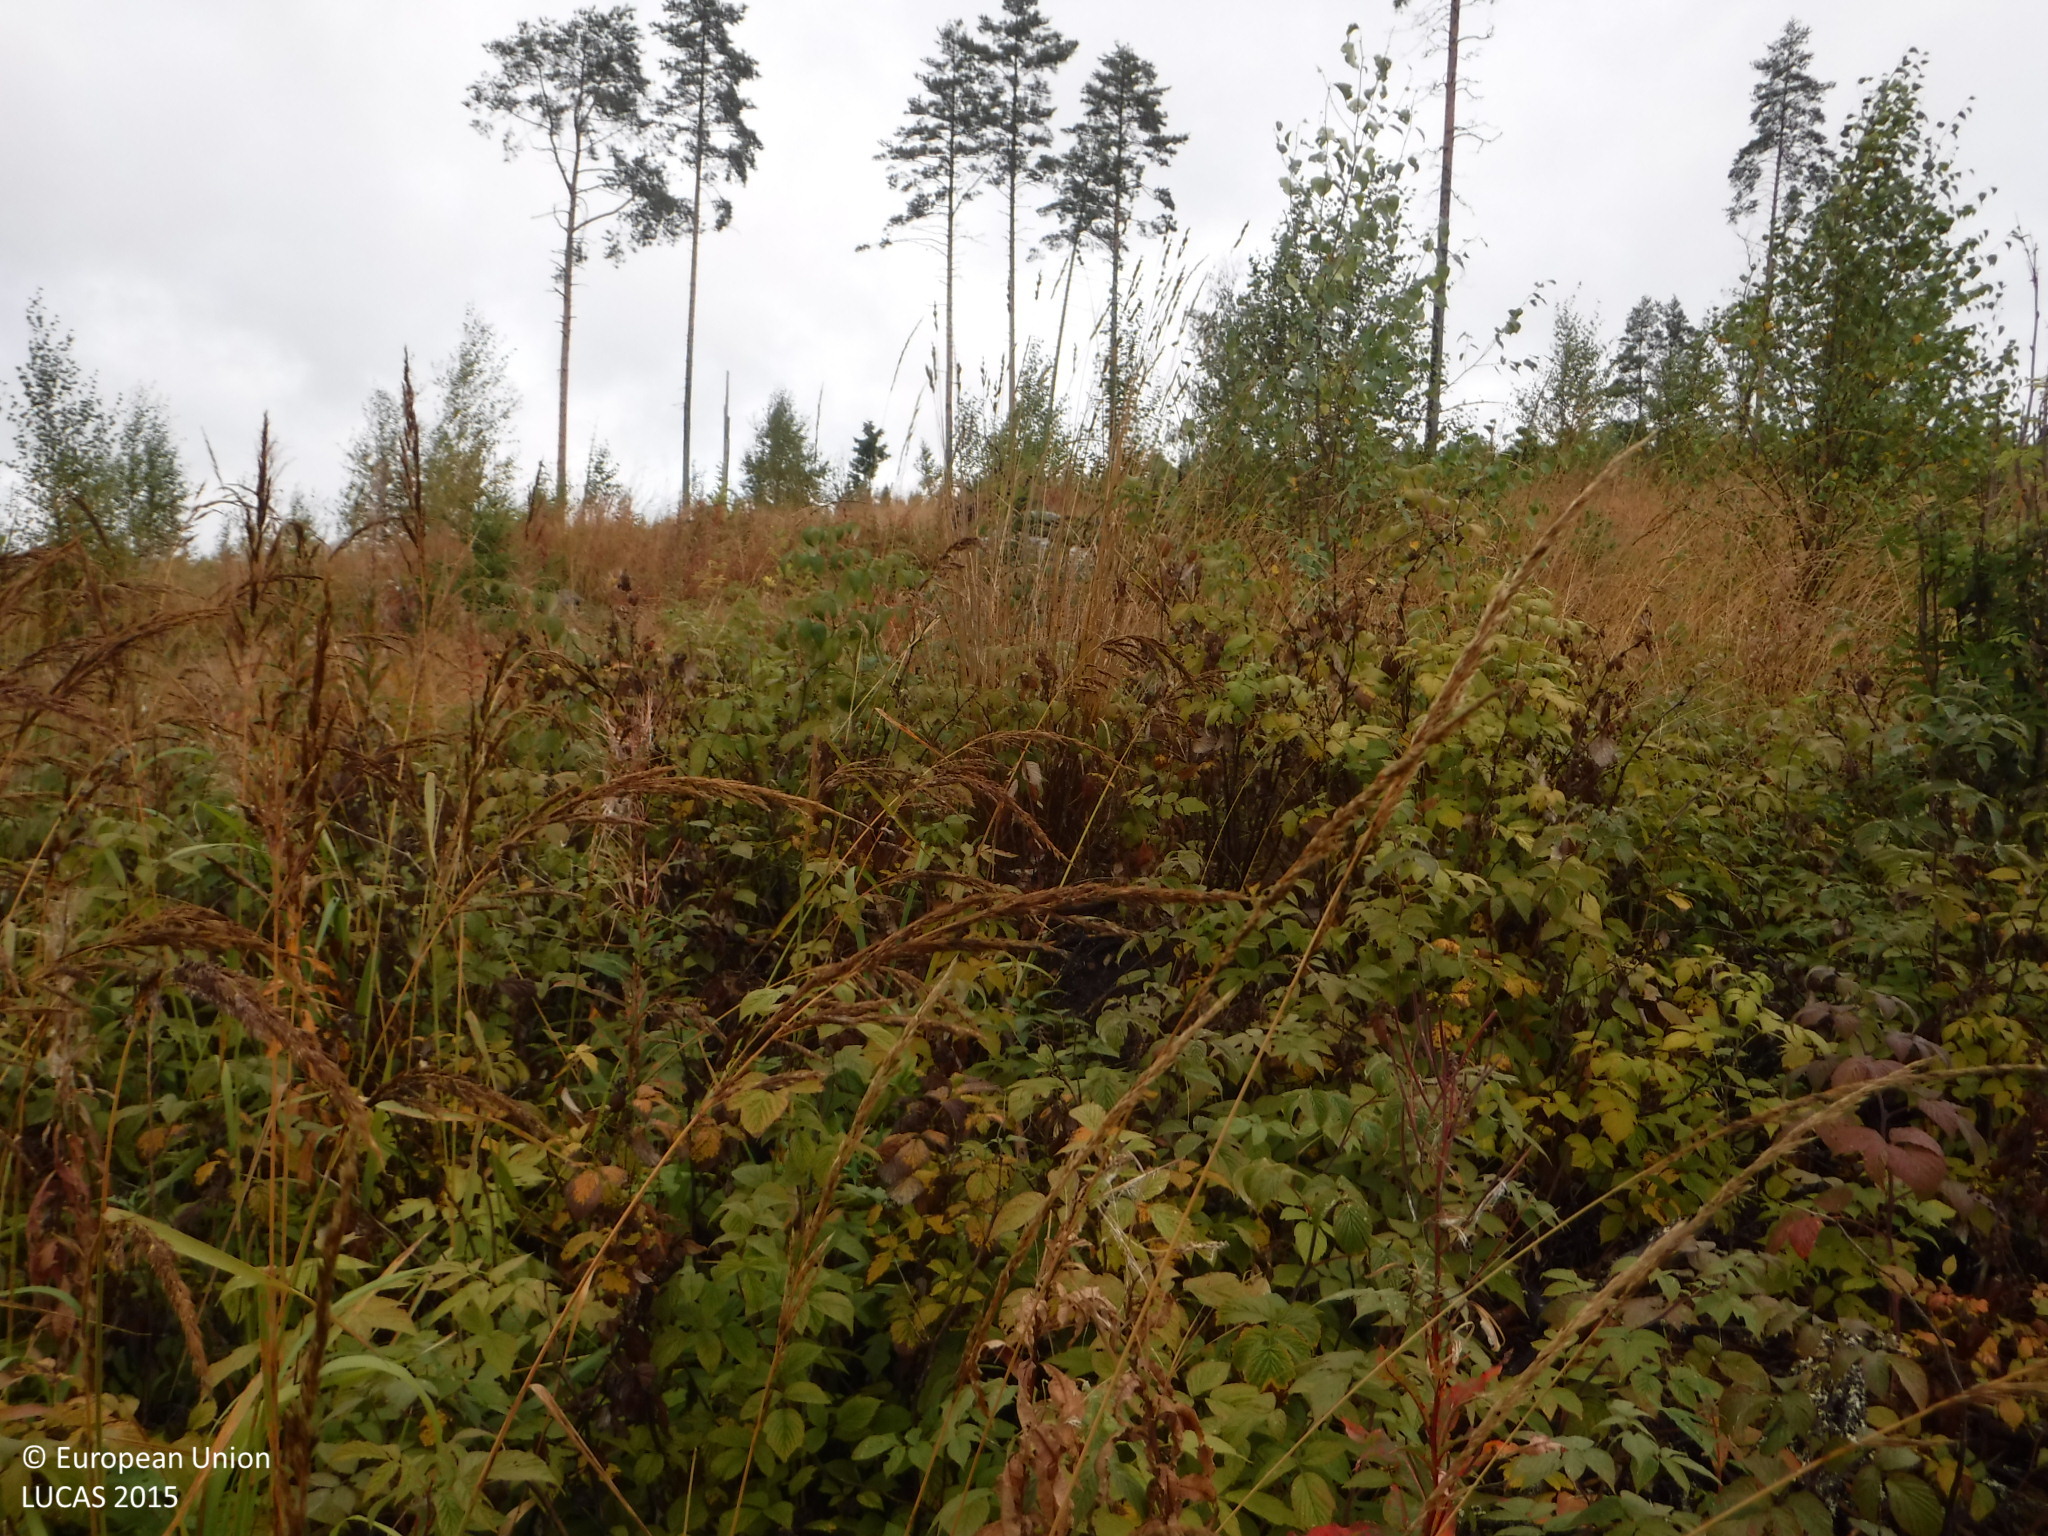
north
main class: Shrubland
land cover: Shrubland with sparse tree cover
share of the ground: 50 - 75 %
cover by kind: herbaceous plants 50 %, shrubs 45 %, broadleaved forest trees 5 %
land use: Forestry
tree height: < 5 m
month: September
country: FI
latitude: 61.3198
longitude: 23.1310
